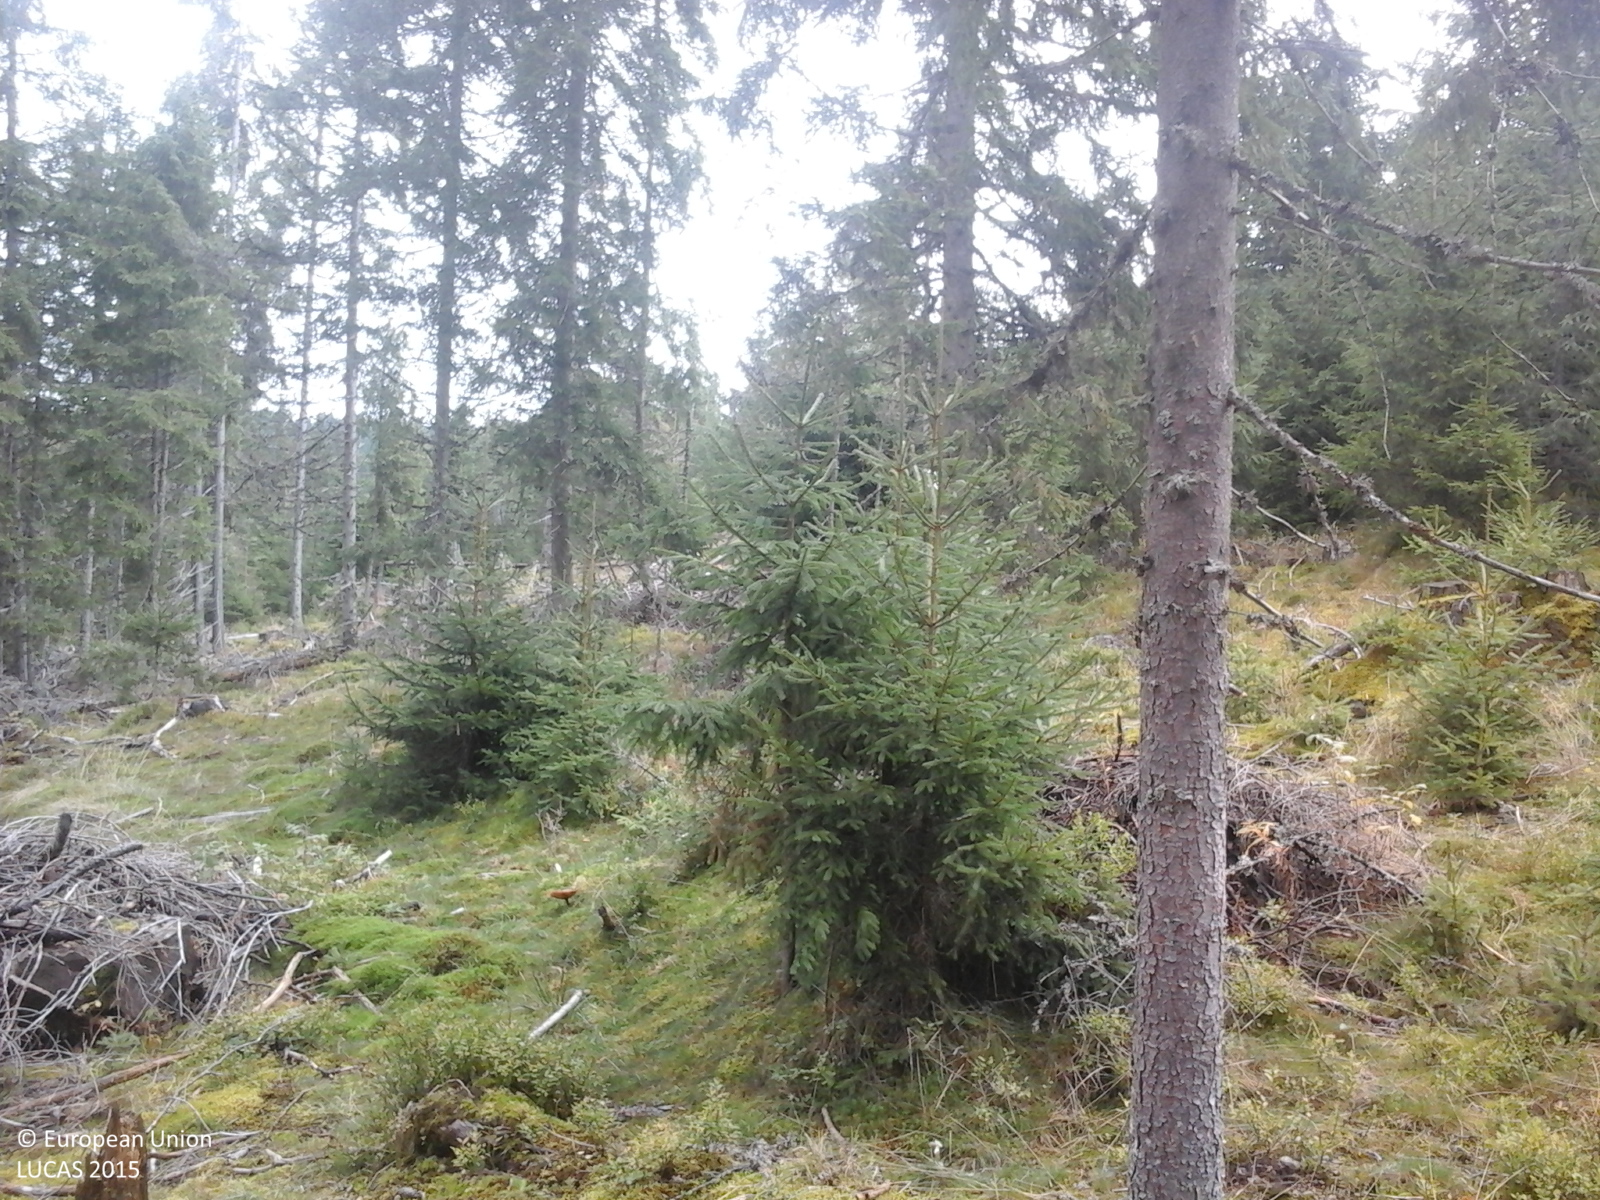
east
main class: Woodland
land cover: Spruce dominated coniferous woodland
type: alpine coniferous forest
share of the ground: > 75 %
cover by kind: coniferous forest trees 100 %
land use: Forestry
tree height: > 5 m
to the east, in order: Spruce dominated coniferous woodland; Tracks; Spruce dominated coniferous woodland
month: September
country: RO
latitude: 46.5344
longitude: 23.0333
